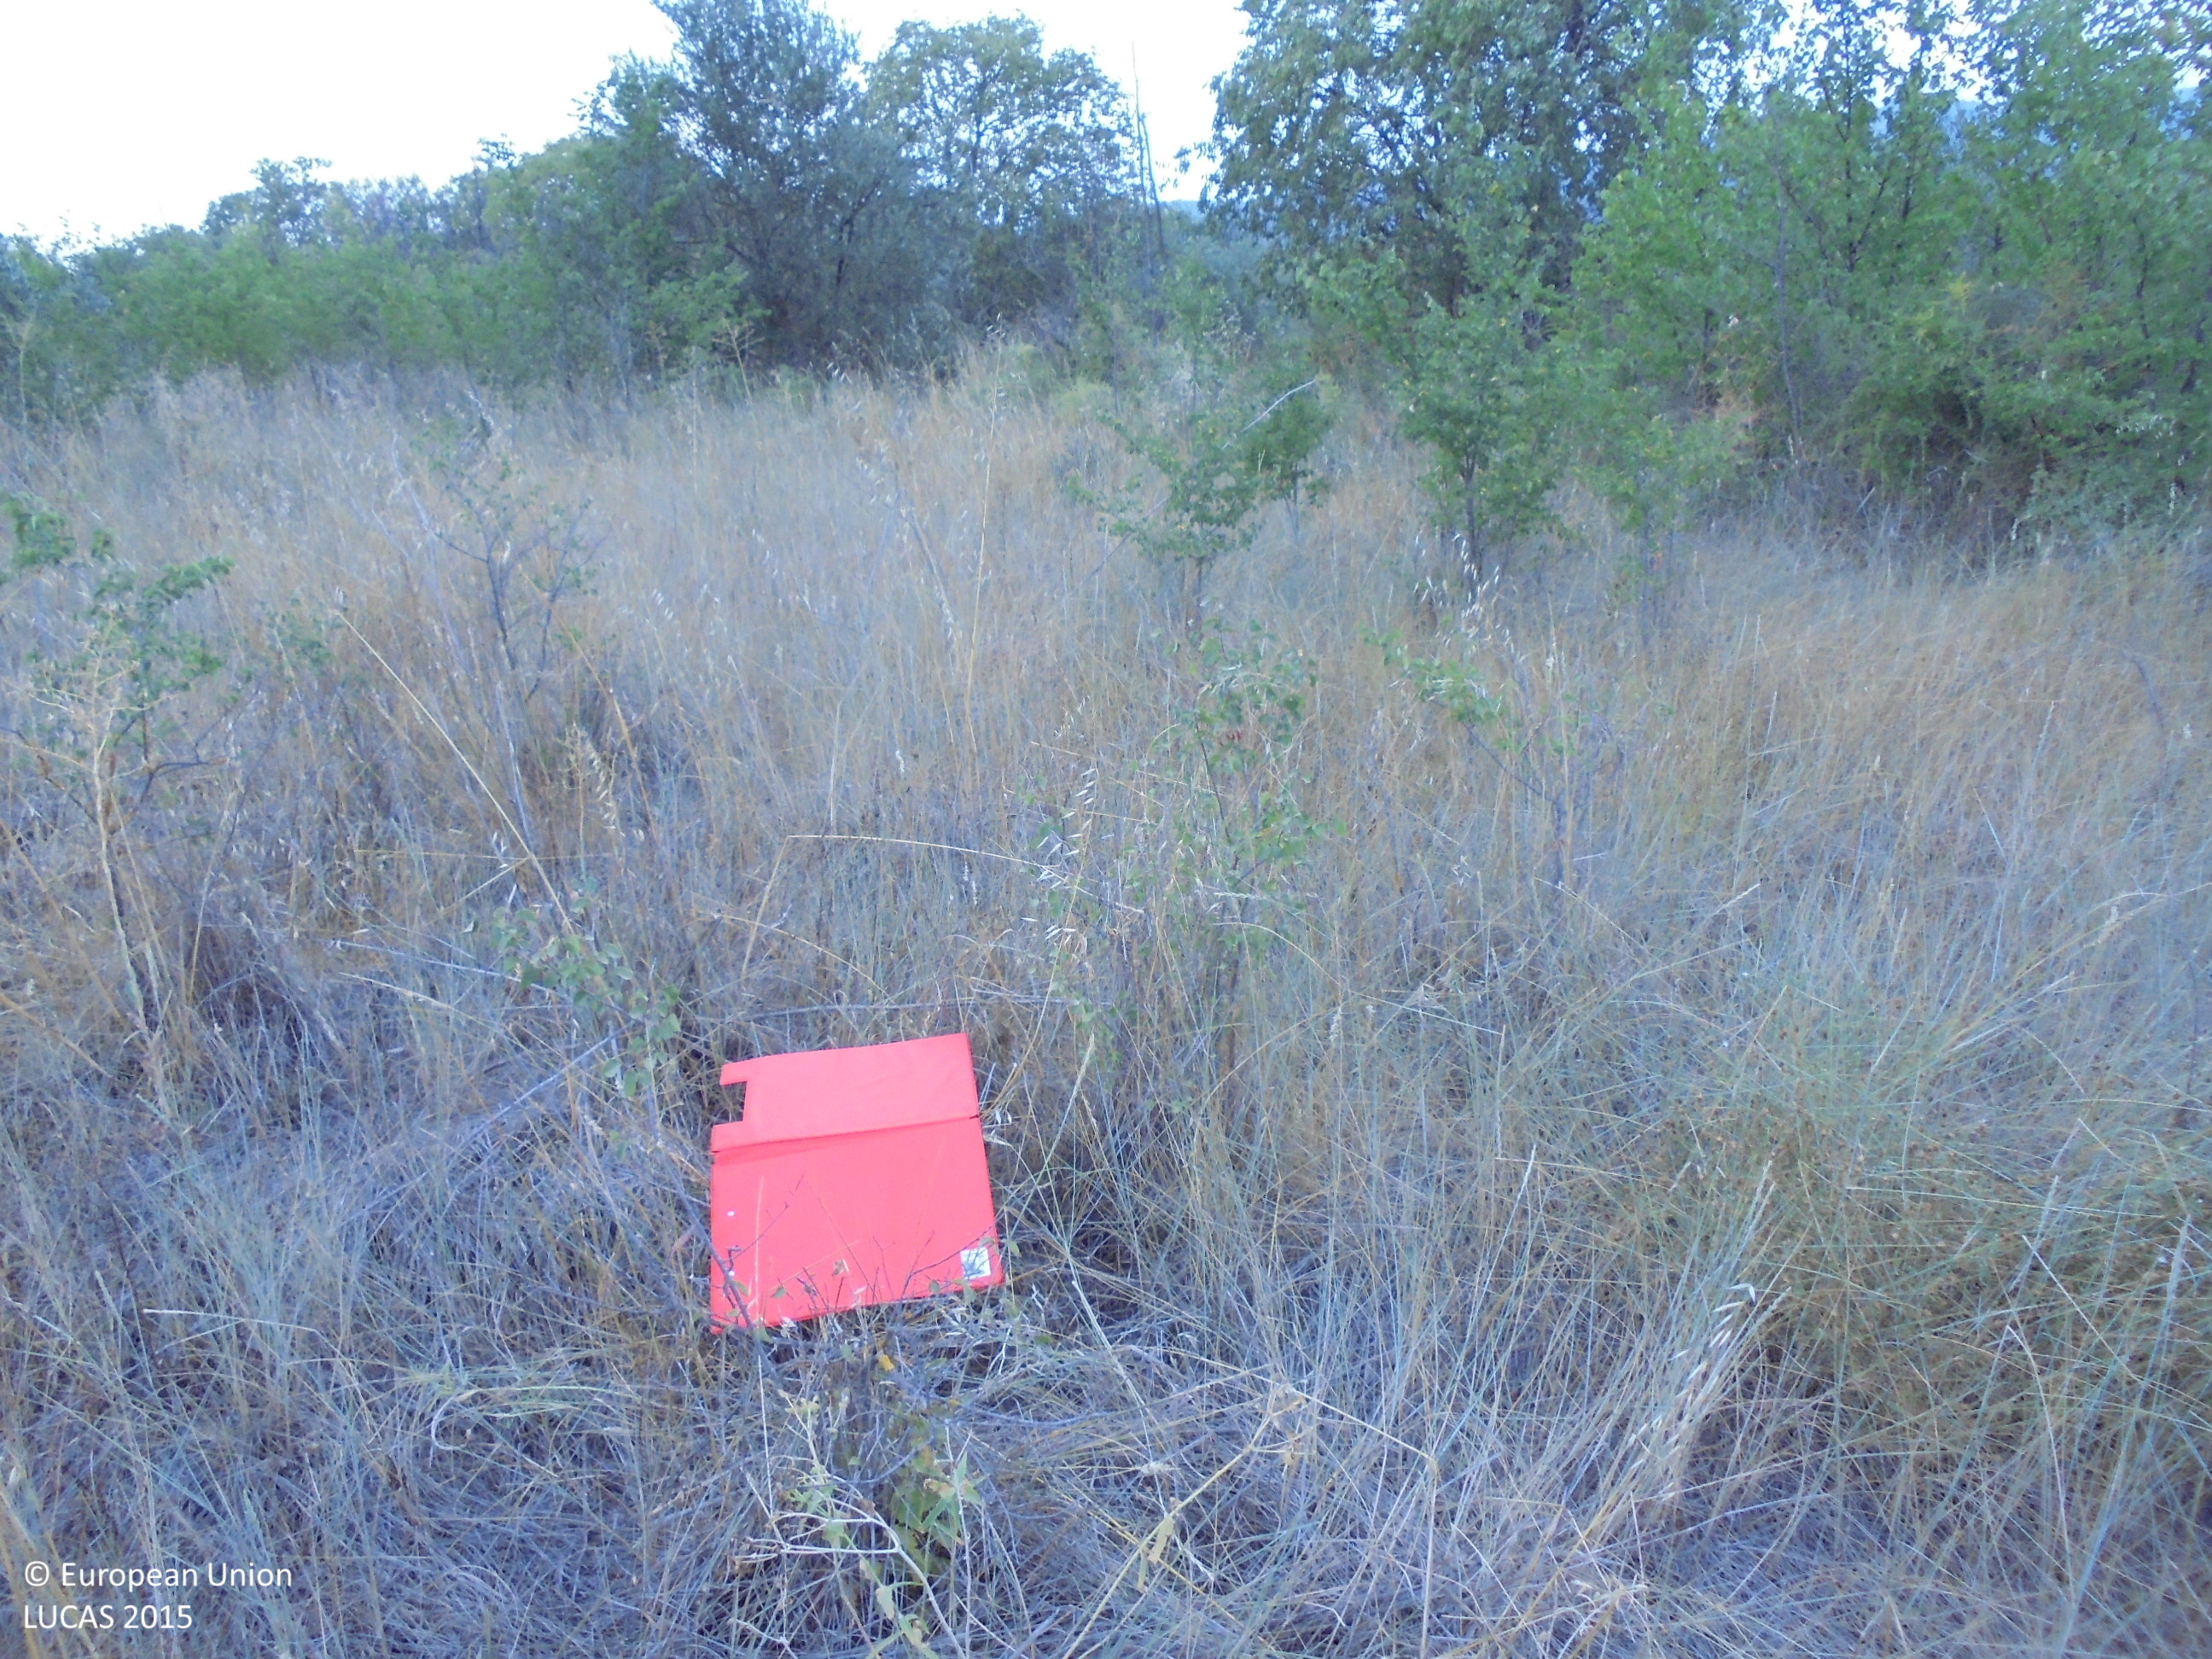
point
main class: Grassland
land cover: Grassland with sparse tree/shrub cover
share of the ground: > 75 %
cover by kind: herbaceous plants 95 %, broadleaved forest trees 5 %
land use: Abandoned areas
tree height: < 5 m
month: July
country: ES
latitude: 39.0949
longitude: -1.0383
